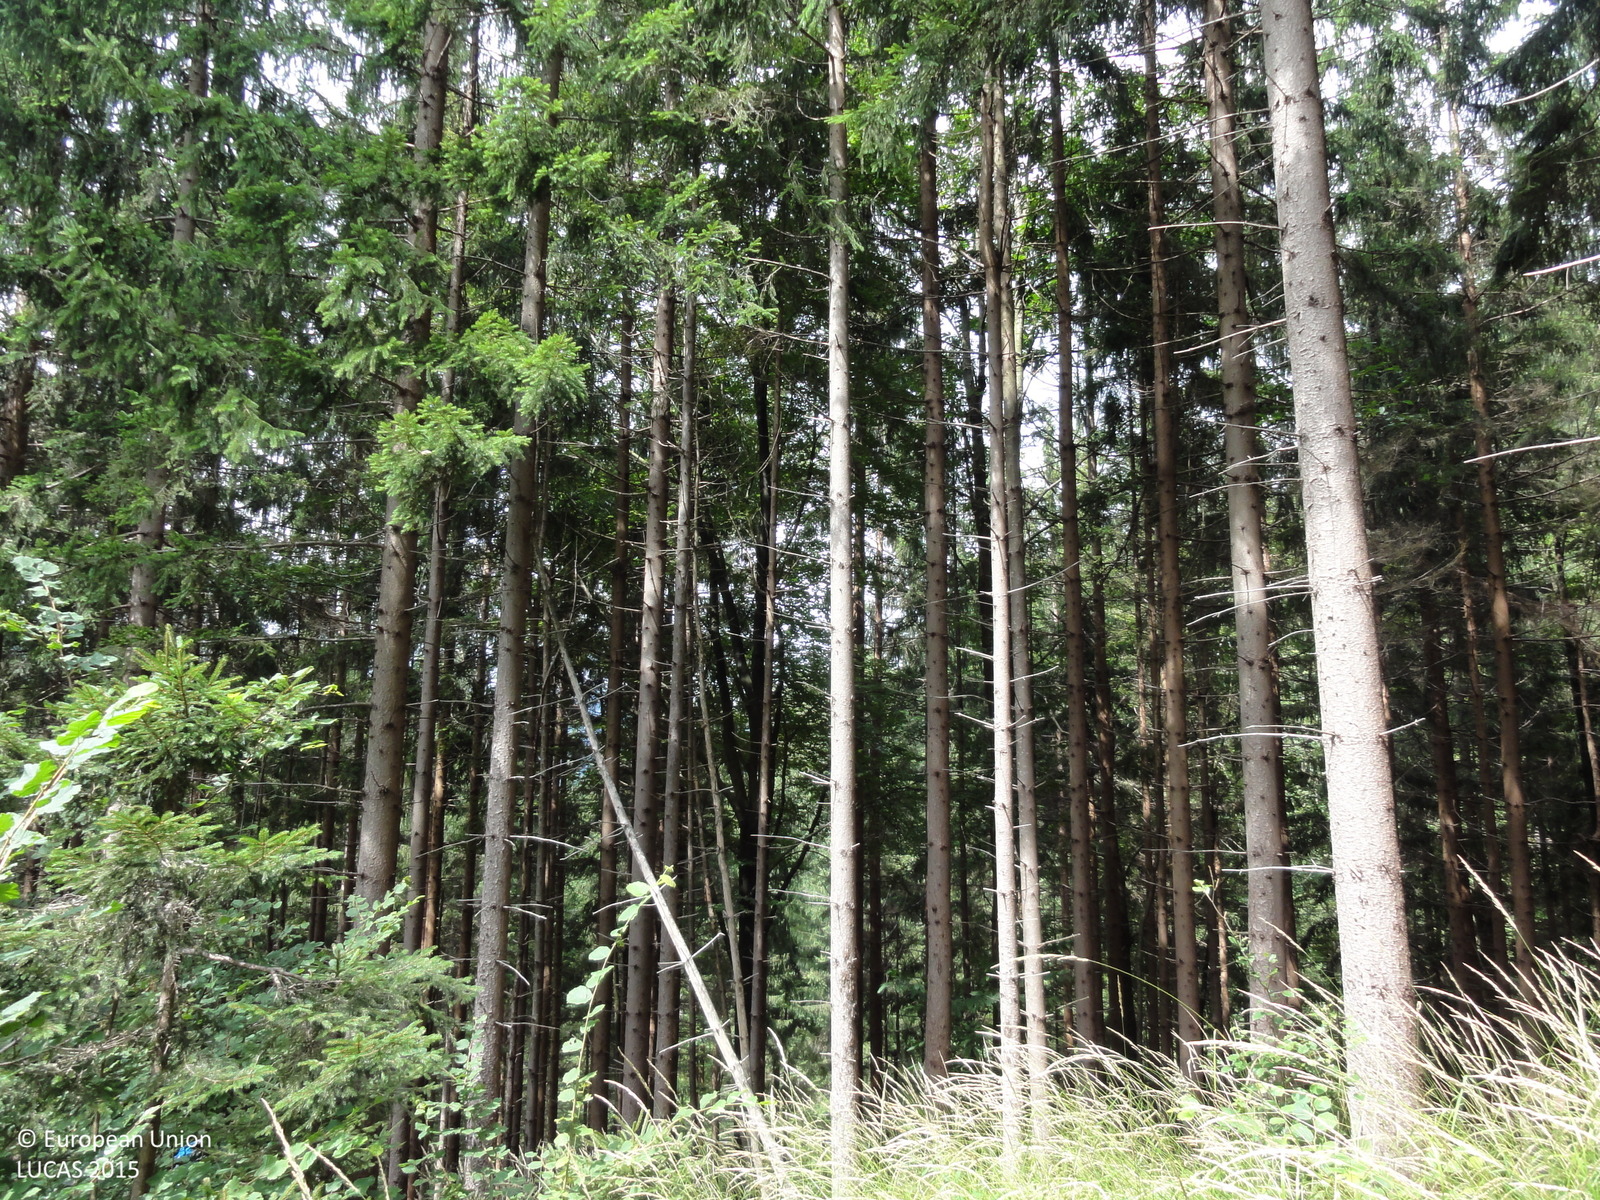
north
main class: Woodland
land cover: Spruce dominated coniferous woodland
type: hemiboreal forest and nemoral coniferous forest and mixed broadleaved-coniferous forest
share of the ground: > 75 %
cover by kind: coniferous forest trees 100 %
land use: Forestry
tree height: > 5 m
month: August
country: SI
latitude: 46.3329
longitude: 14.8168
